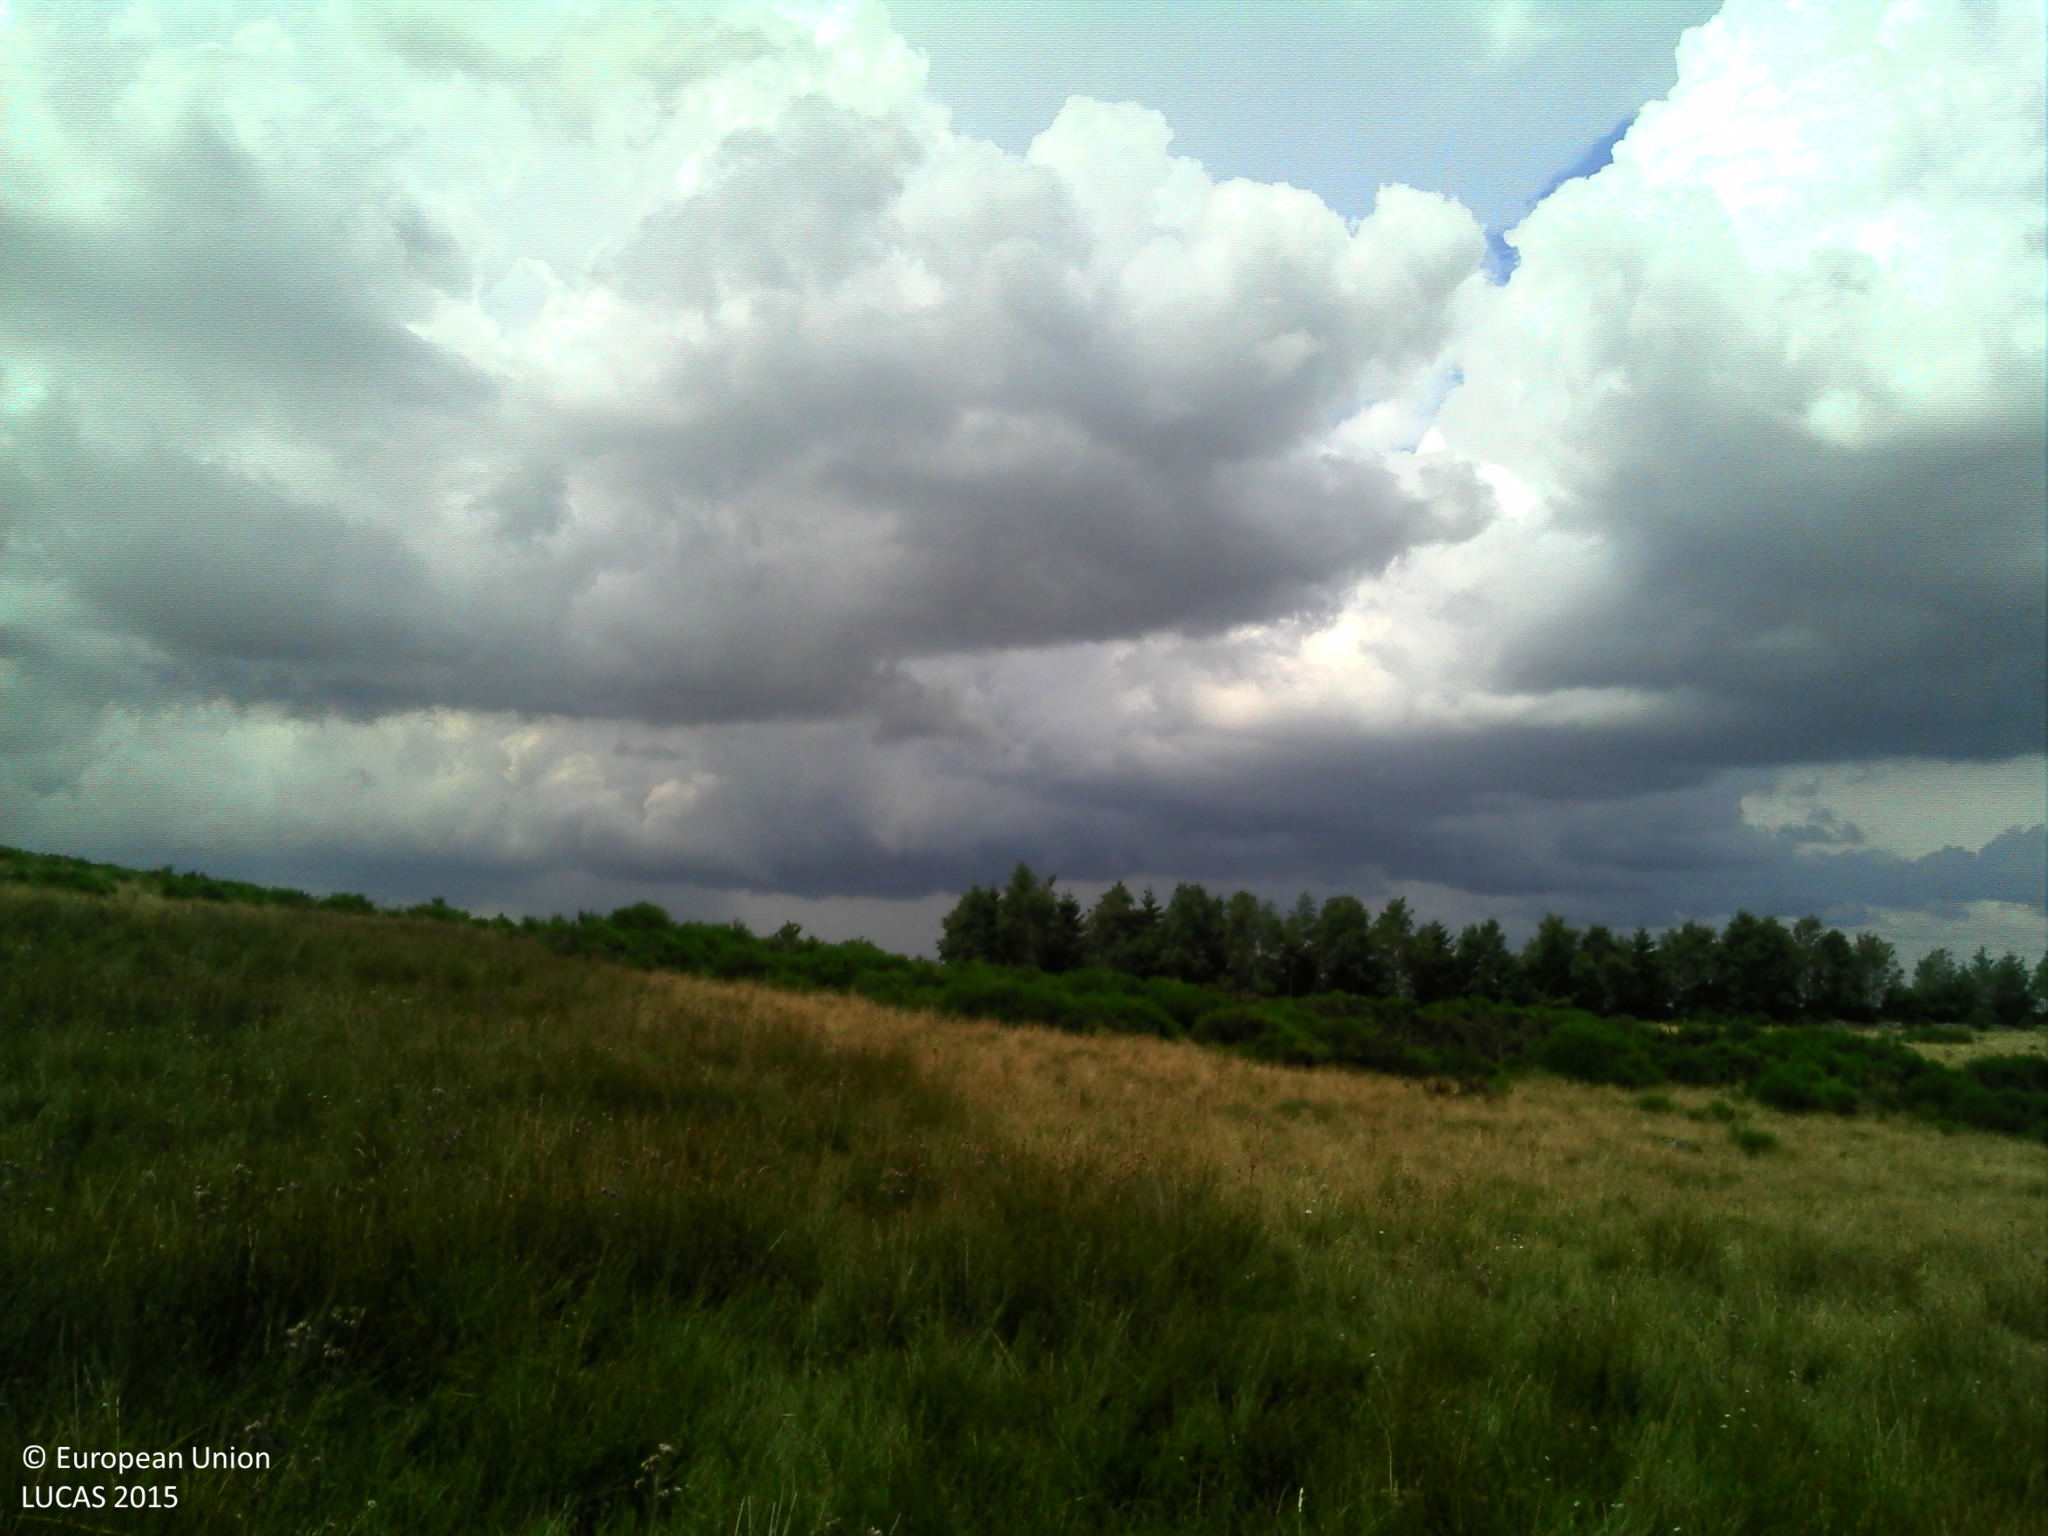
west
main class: Grassland
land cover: Grassland without tree/shrub cover
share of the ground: > 75 %
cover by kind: herbaceous plants 95 %, shrubs 5 %
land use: Agriculture (excluding fallow land and kitchen gardens)
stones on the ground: < 10 %
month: July
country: FR
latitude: 44.7161
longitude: 3.0730
